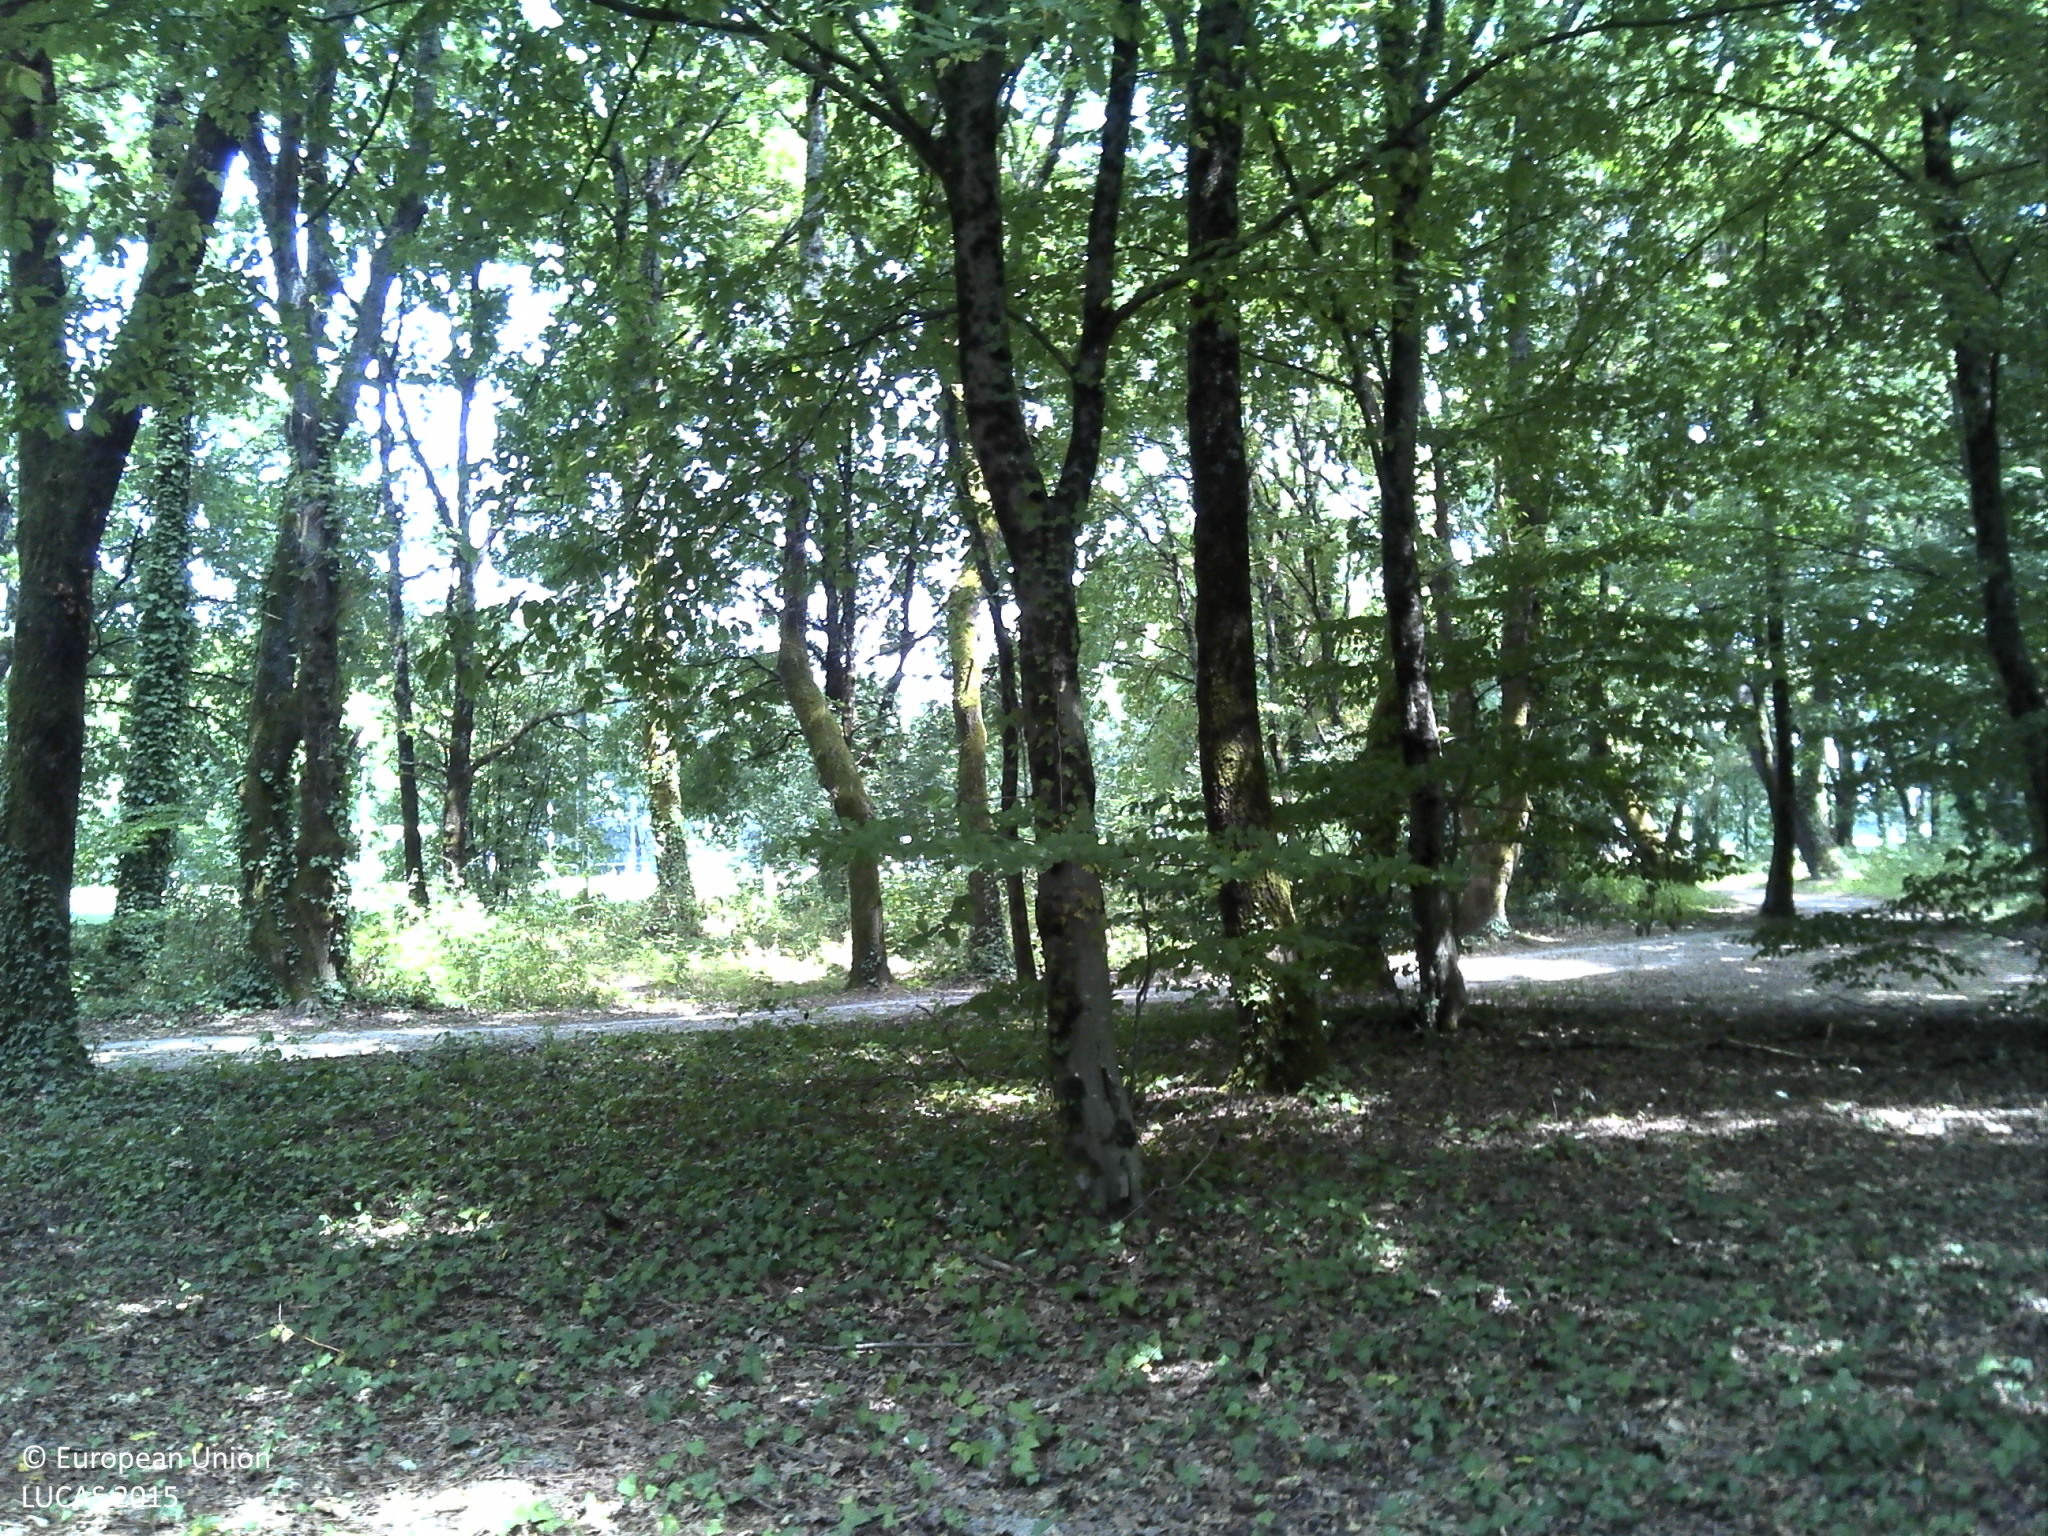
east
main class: Woodland
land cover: Broadleaved woodland
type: mesophytic deciduous forest
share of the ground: > 75 %
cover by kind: broadleaved forest trees 70 %, unconsolidated bare surface 15 %, herbaceous plants 10 %, coniferous forest trees 5 %
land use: Forestry
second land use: Sport
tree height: > 5 m
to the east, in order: Broadleaved woodland; Tracks; Broadleaved woodland; Grassland without tree/shrub cover; Fences; Broadleaved woodland; Tracks; Broadleaved woodland; Ditches and canals; Grassland without tree/shrub cover; Fences; Grassland without tree/shrub cover; Fences; Grass margins; Fences; Grass margins; Other bare soil; Tracks
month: July
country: FR
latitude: 44.7878
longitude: -0.5975
